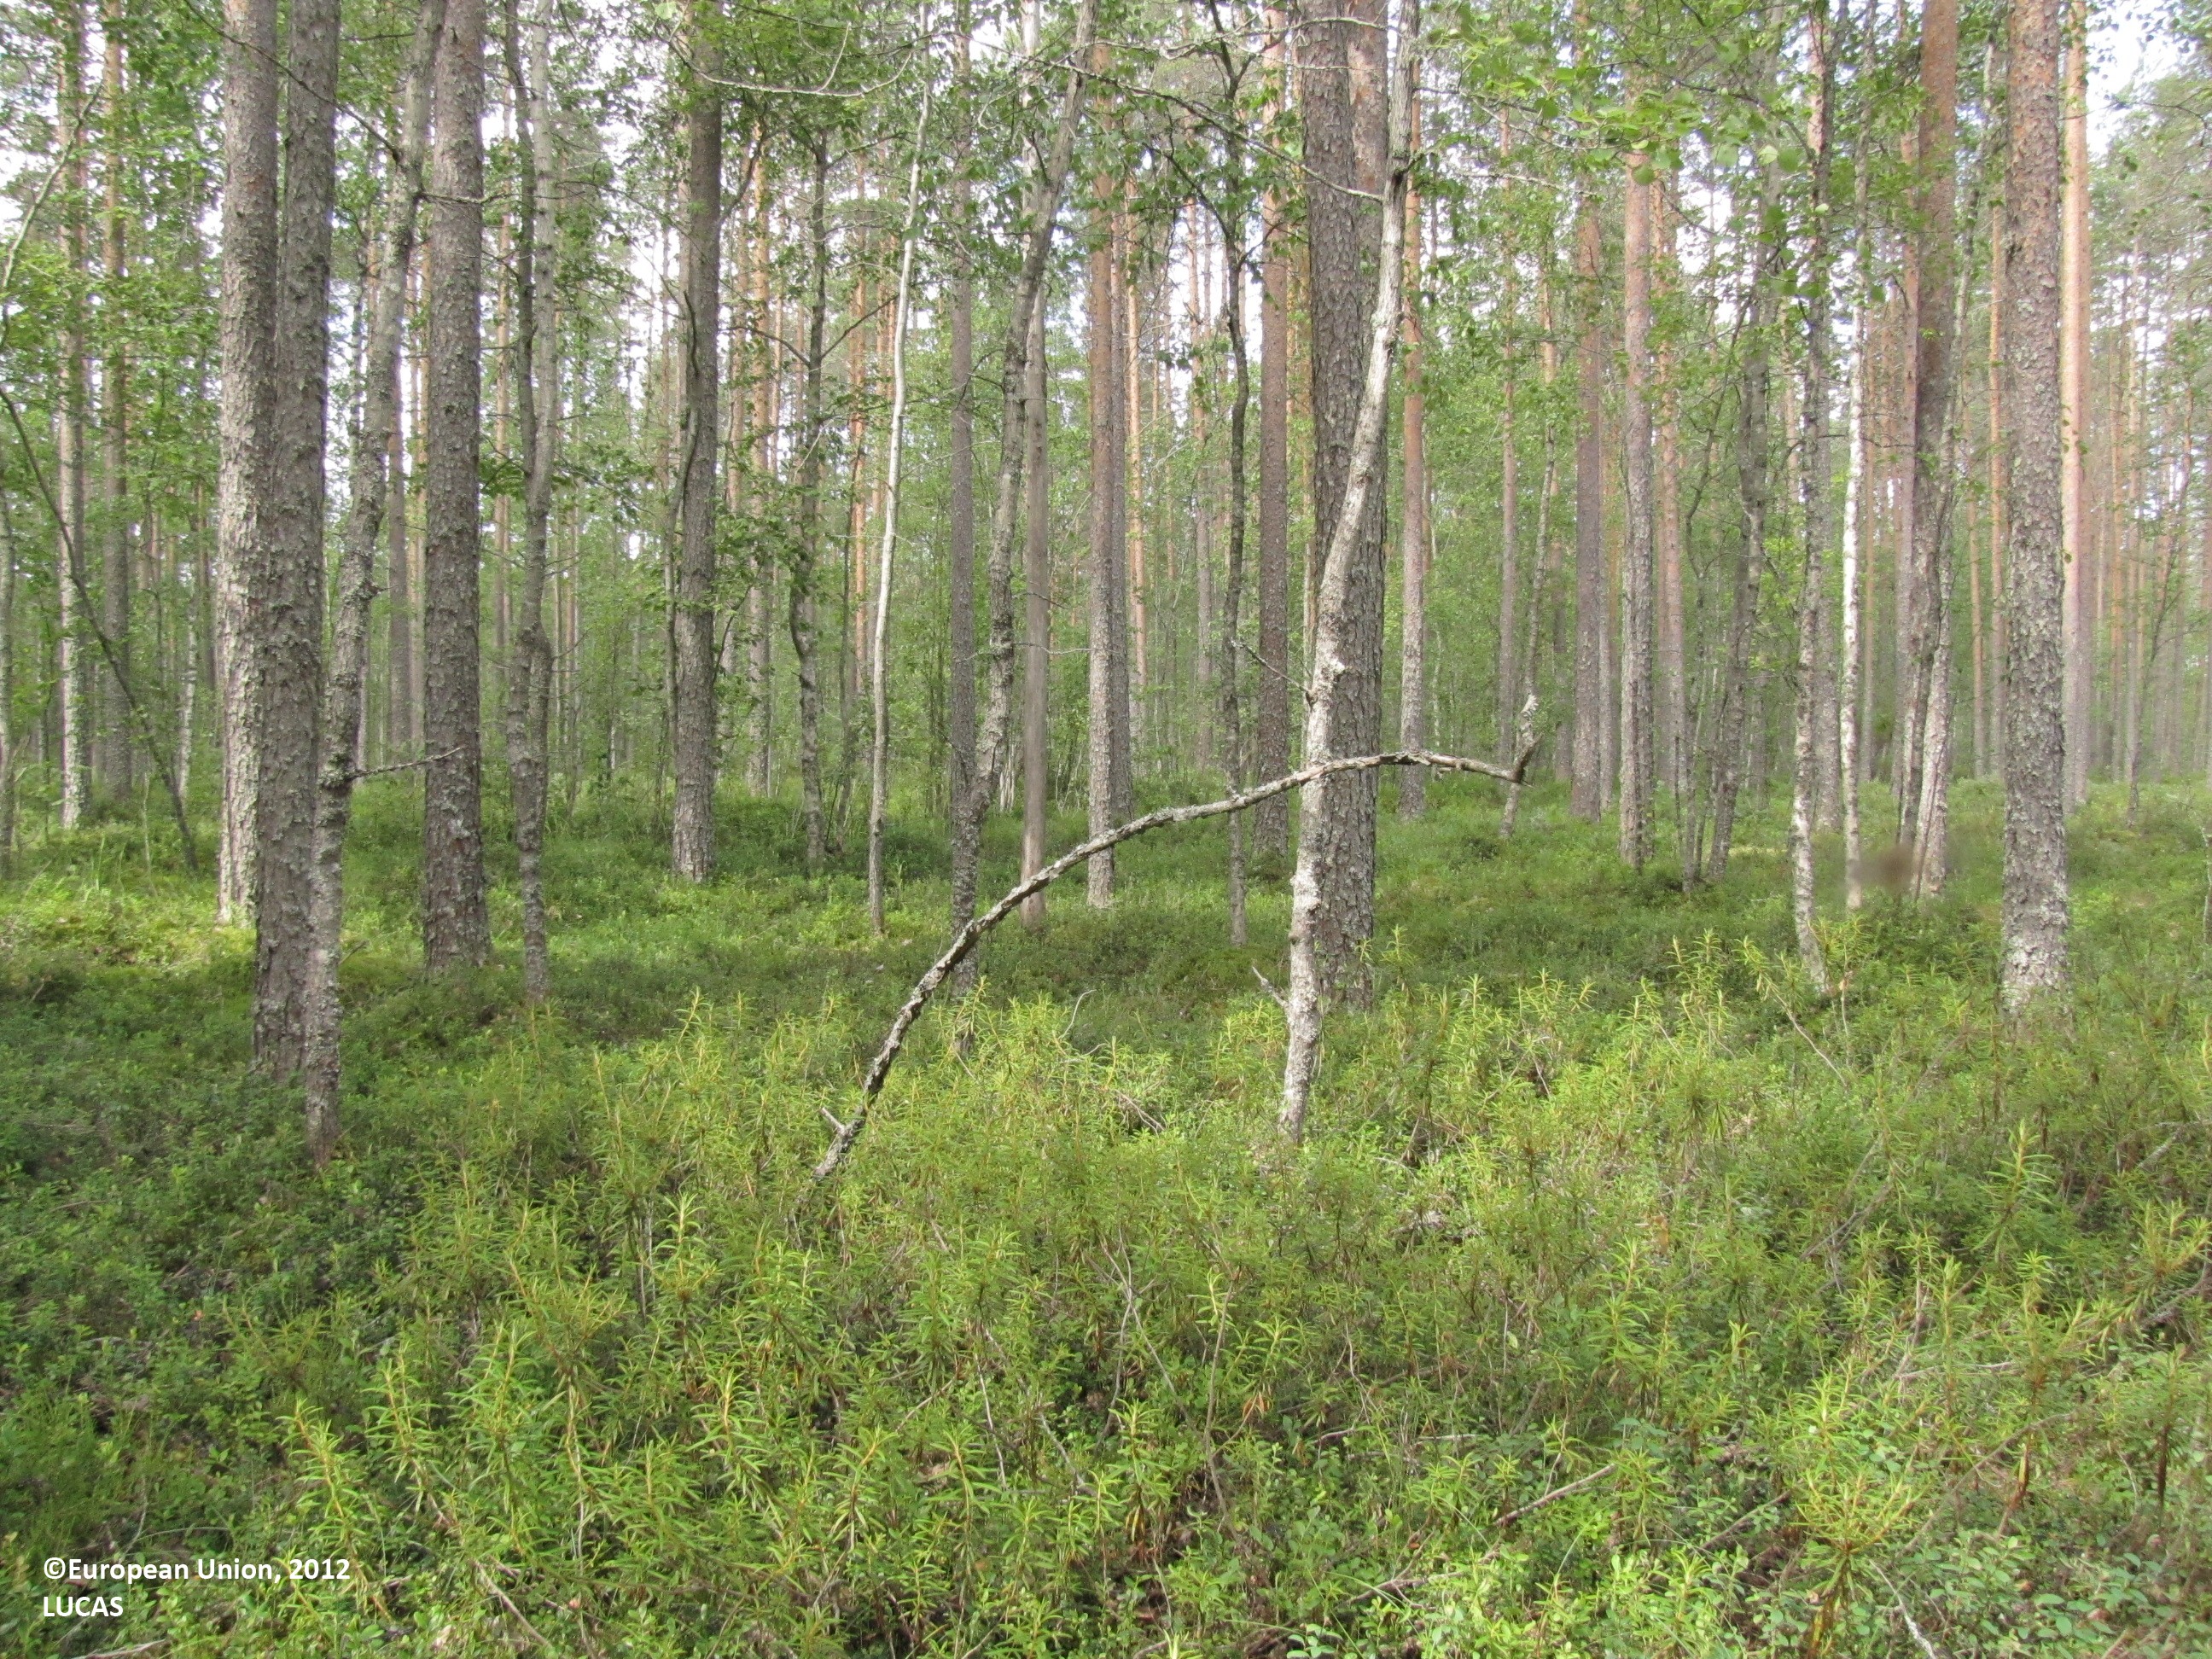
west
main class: Woodland
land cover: Pine dominated coniferous woodland
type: mire and swamp forests
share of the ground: > 75 %
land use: Forestry
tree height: > 5 m
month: July
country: FI
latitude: 62.4087
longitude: 23.2474
